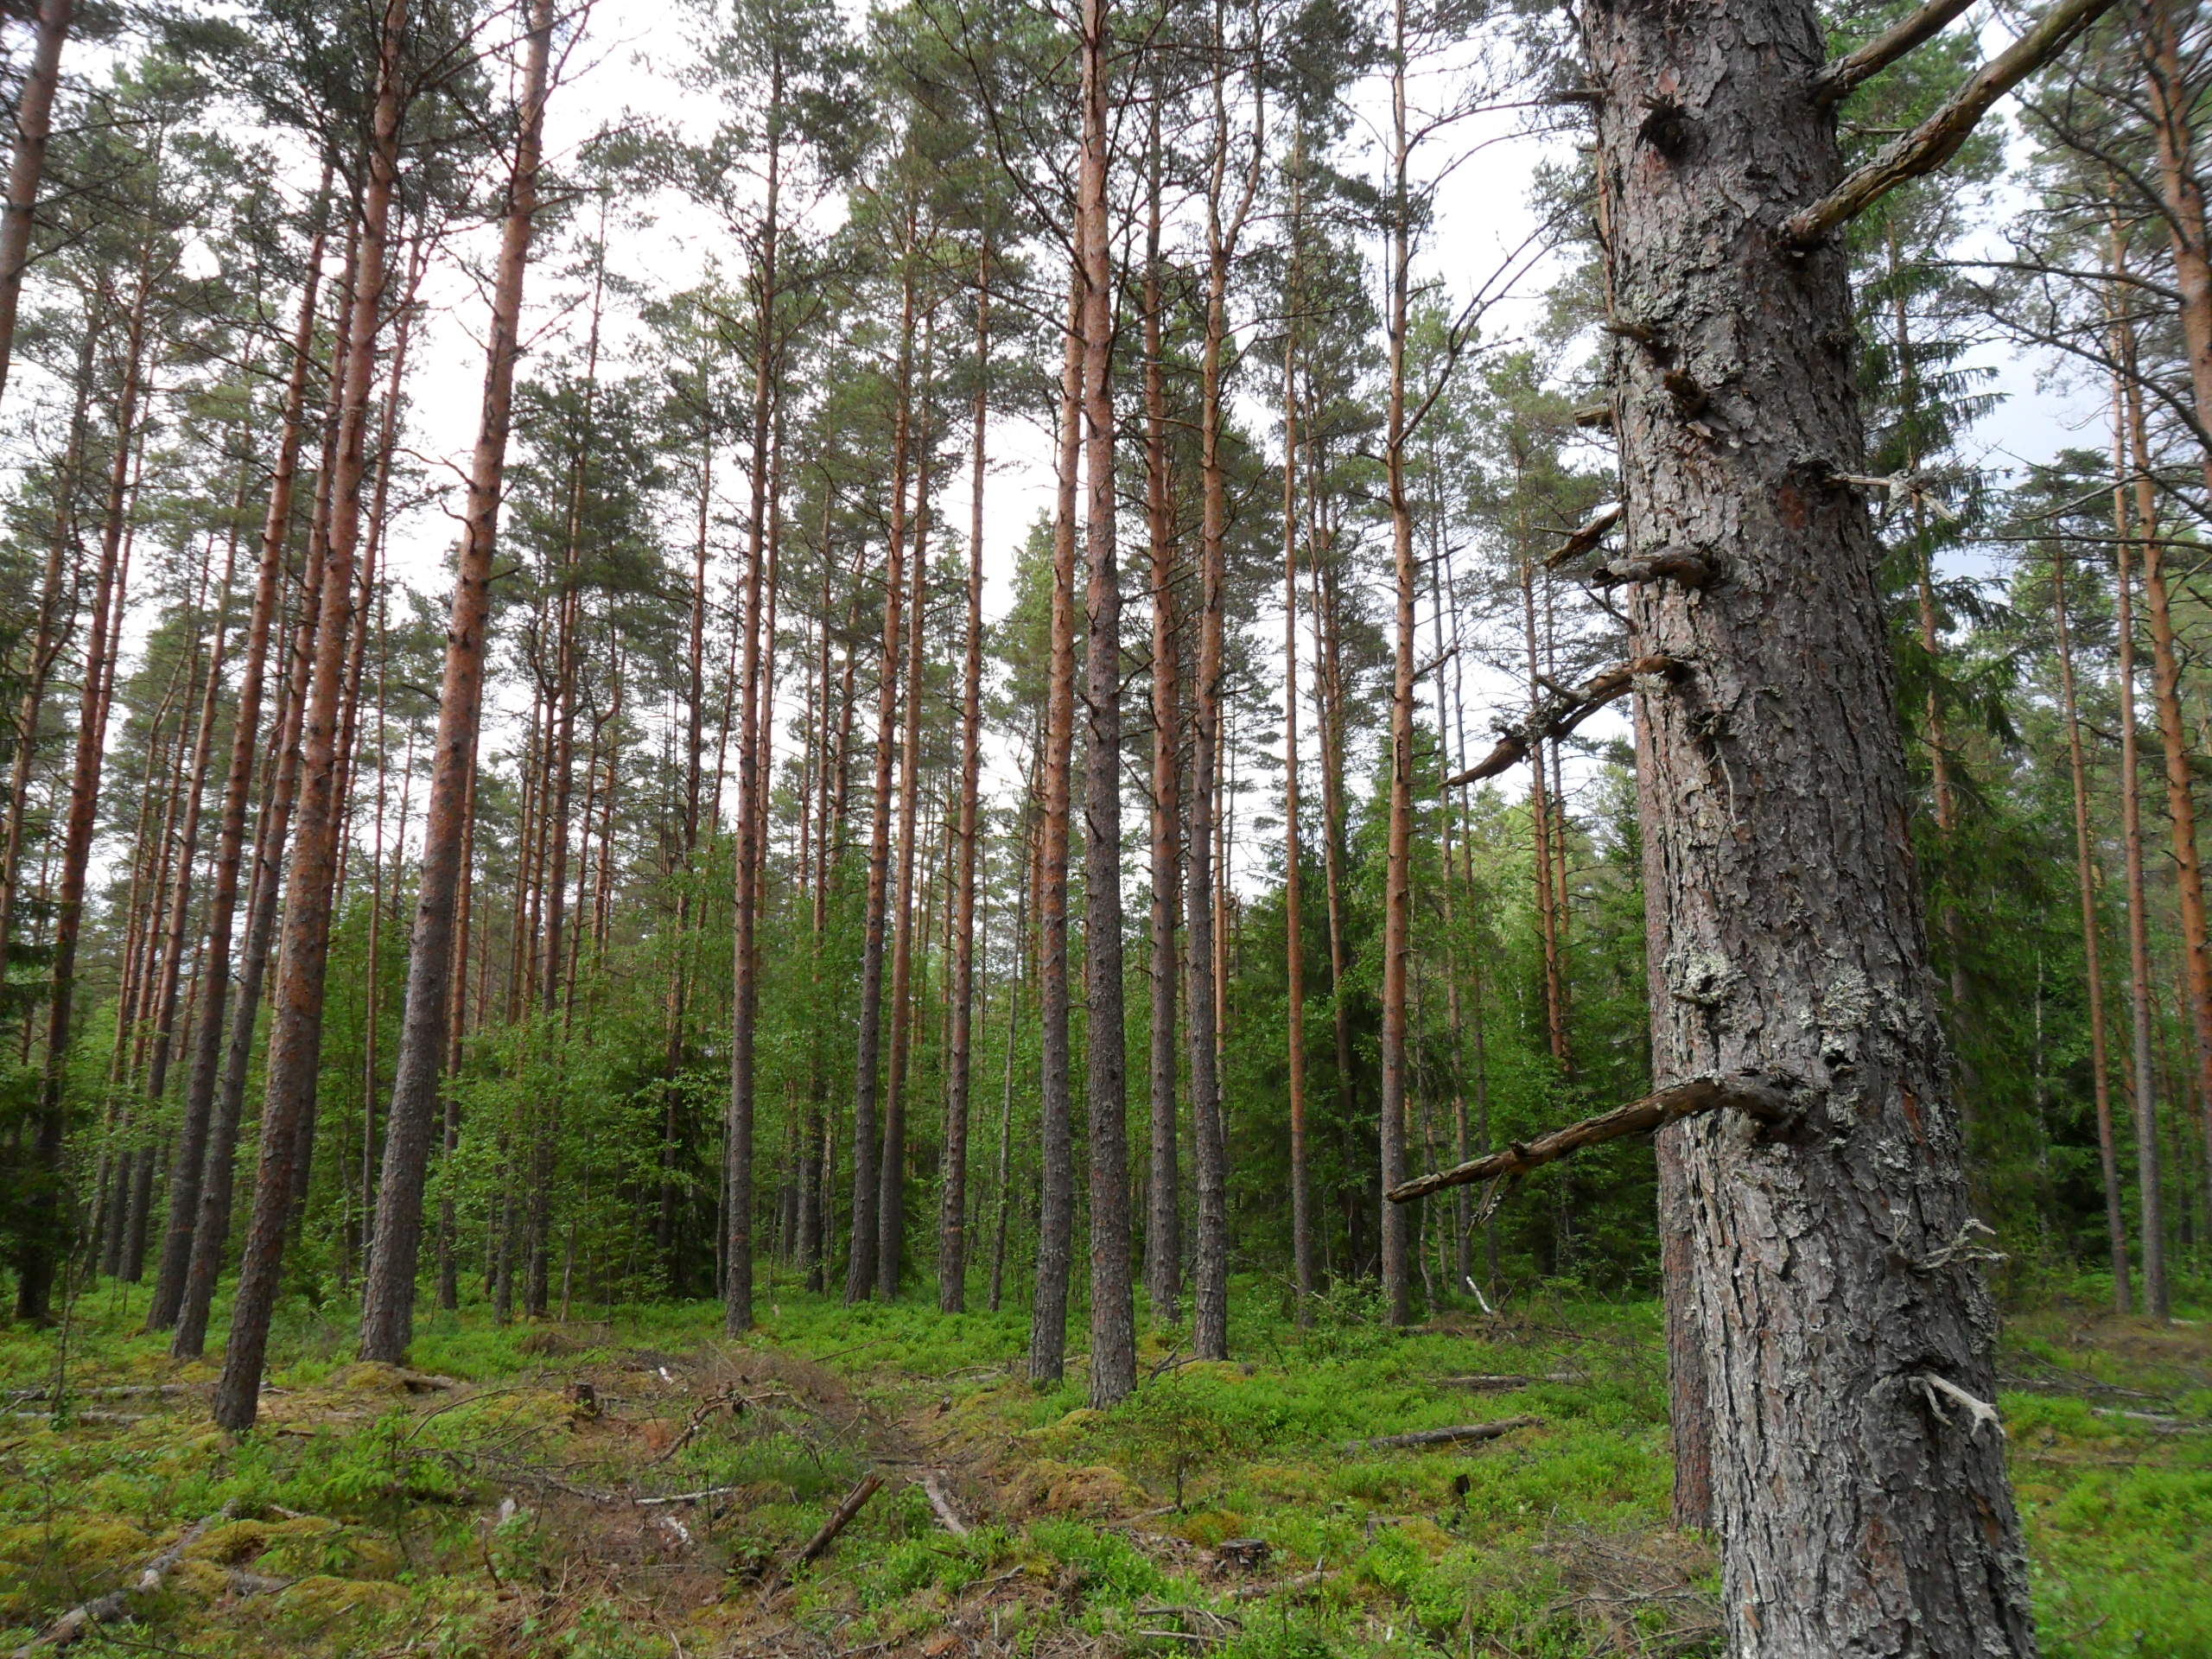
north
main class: Woodland
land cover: Pine dominated coniferous woodland
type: hemiboreal forest and nemoral coniferous forest and mixed broadleaved-coniferous forest
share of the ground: 50 - 75 %
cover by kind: coniferous forest trees 70 %, herbaceous plants 20 %, shrubs 10 %
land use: Forestry
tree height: > 5 m
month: June
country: LV
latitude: 57.4607
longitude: 22.2002
